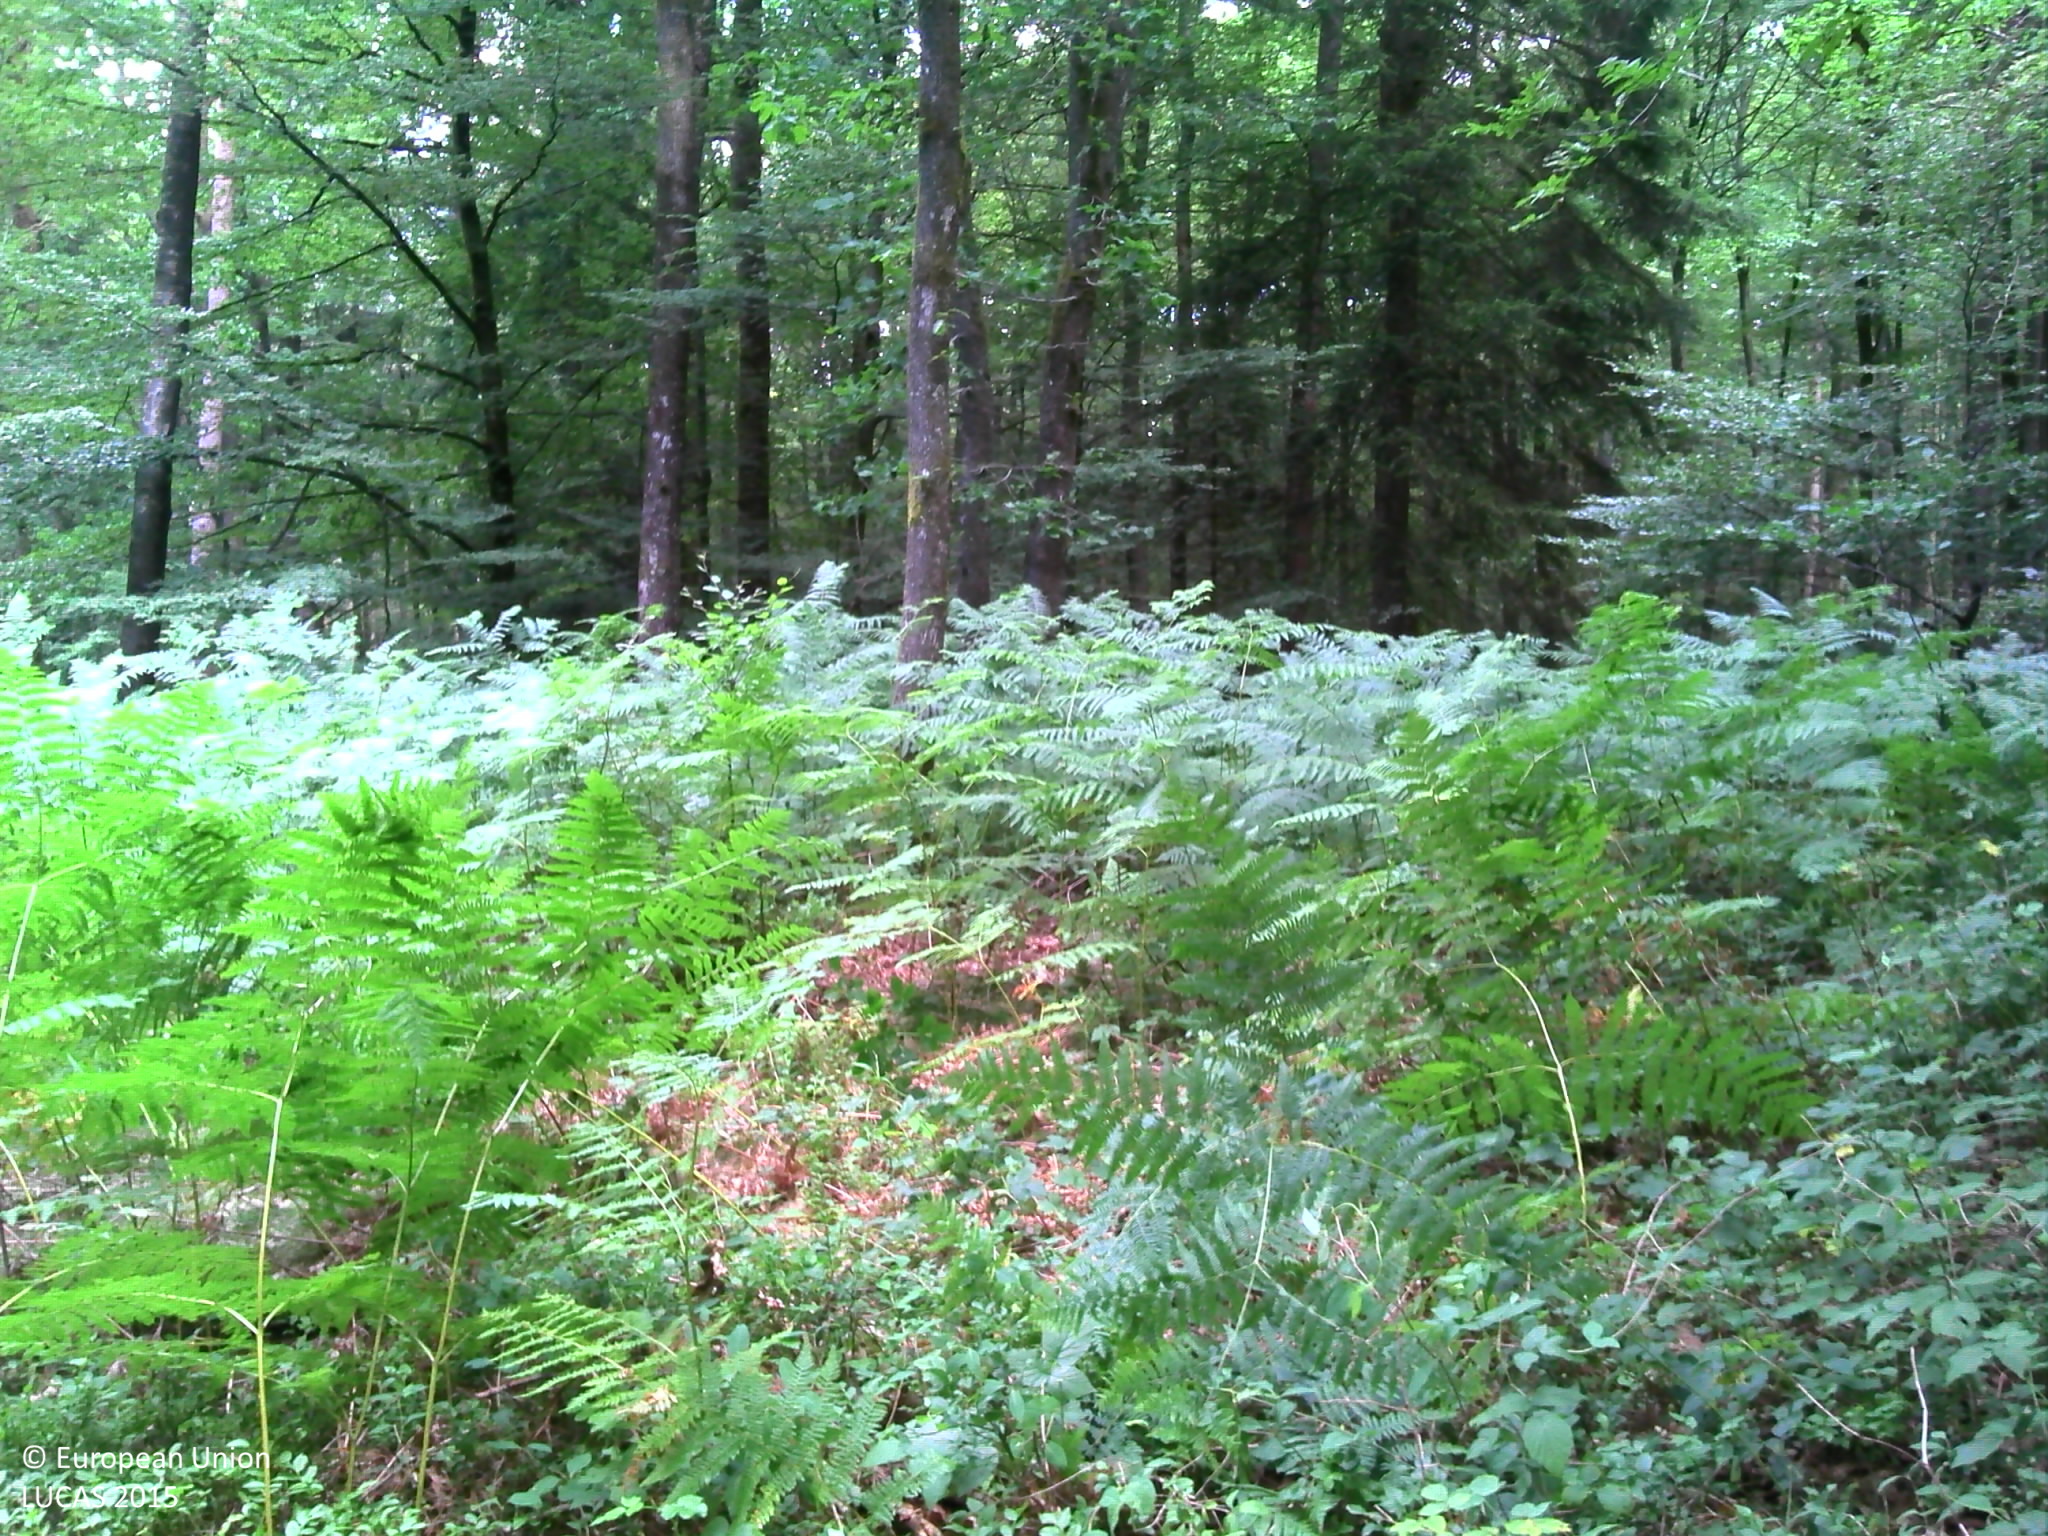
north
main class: Woodland
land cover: Broadleaved woodland
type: acidophilous oak and oak-birch forest
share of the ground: > 75 %
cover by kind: broadleaved forest trees 70 %, herbaceous plants 20 %, coniferous forest trees 10 %
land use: Forestry
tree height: > 5 m
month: July
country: BE
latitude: 49.6336
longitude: 5.6650
